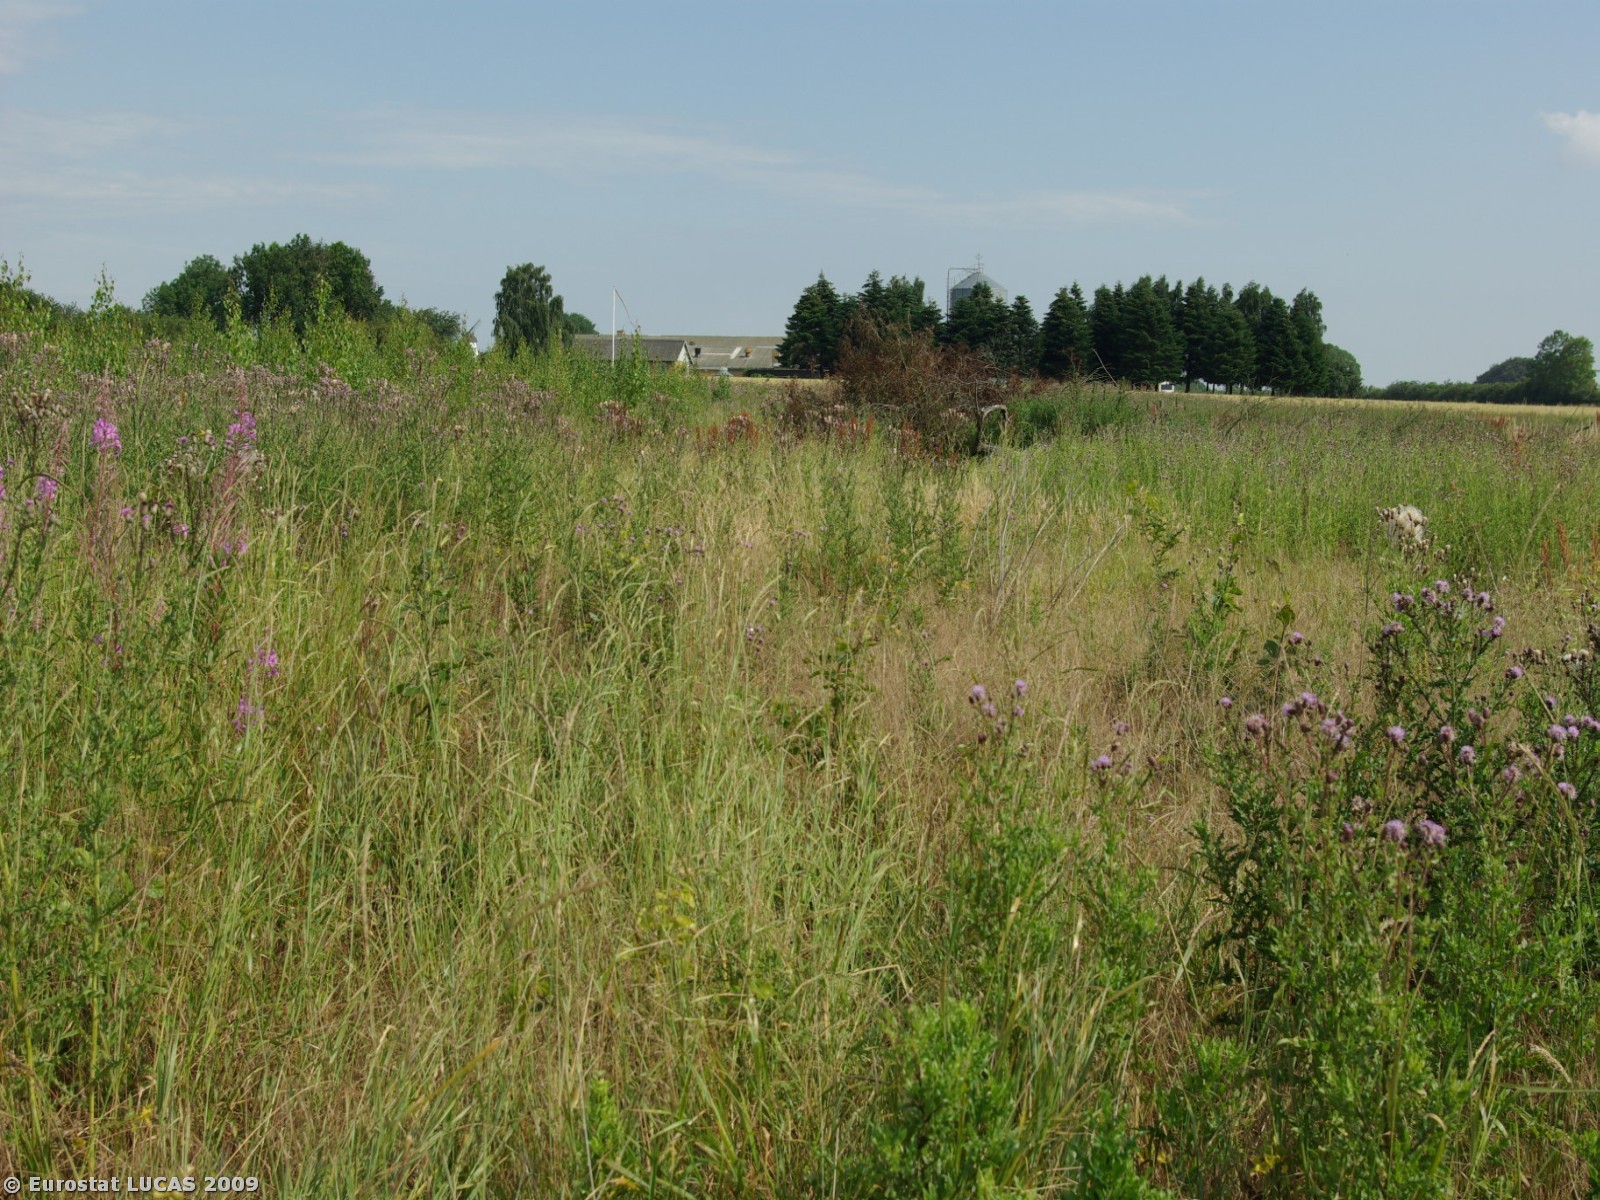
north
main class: Woodland
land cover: Broadleaved woodland
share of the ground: < 10 %
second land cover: Spontaneously vegetated surfaces
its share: > 75 %
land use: Amenities, museums, leisure
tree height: < 5 m
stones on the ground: < 10 %
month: July
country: DK
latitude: 54.9291
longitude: 9.6725
